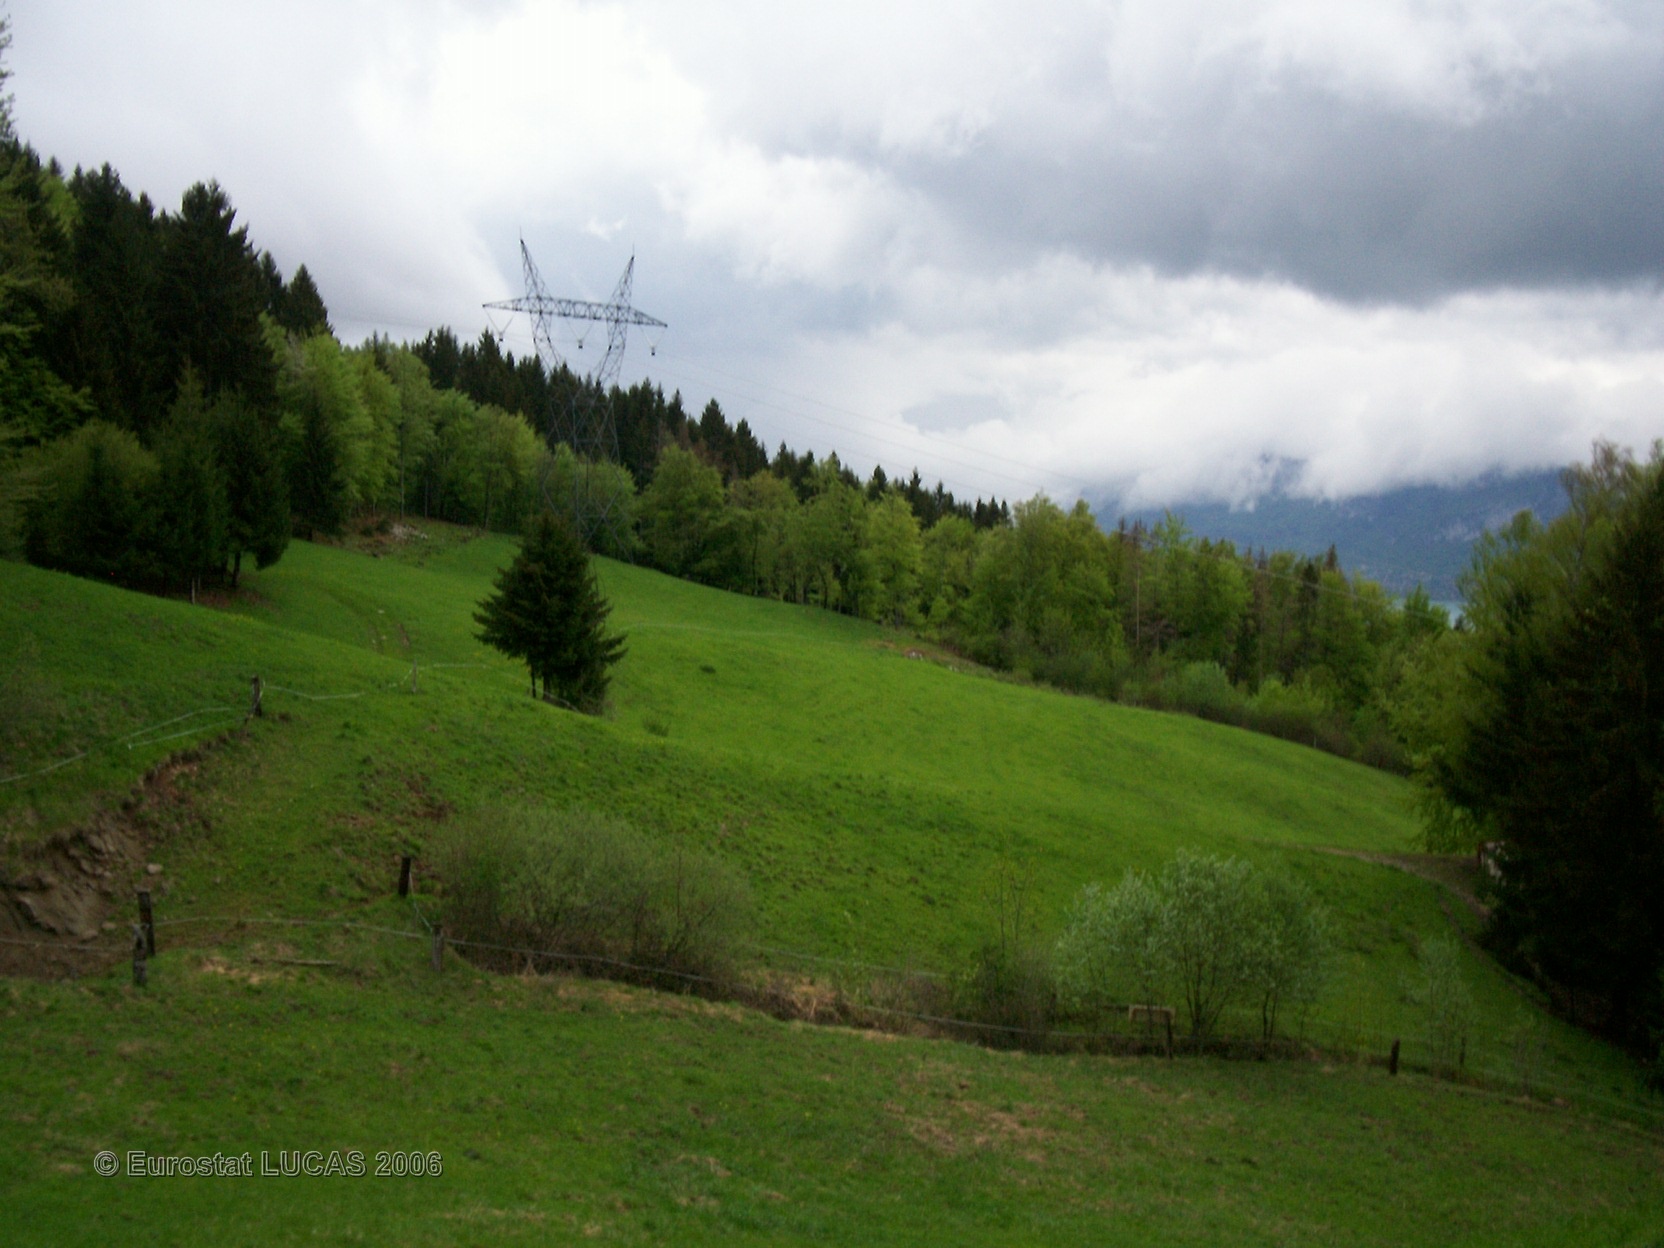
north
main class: Grassland
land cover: Grassland without tree/shrub cover
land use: Agriculture (excluding fallow land and kitchen gardens)
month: May
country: FR
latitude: 45.7944
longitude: 6.1318
